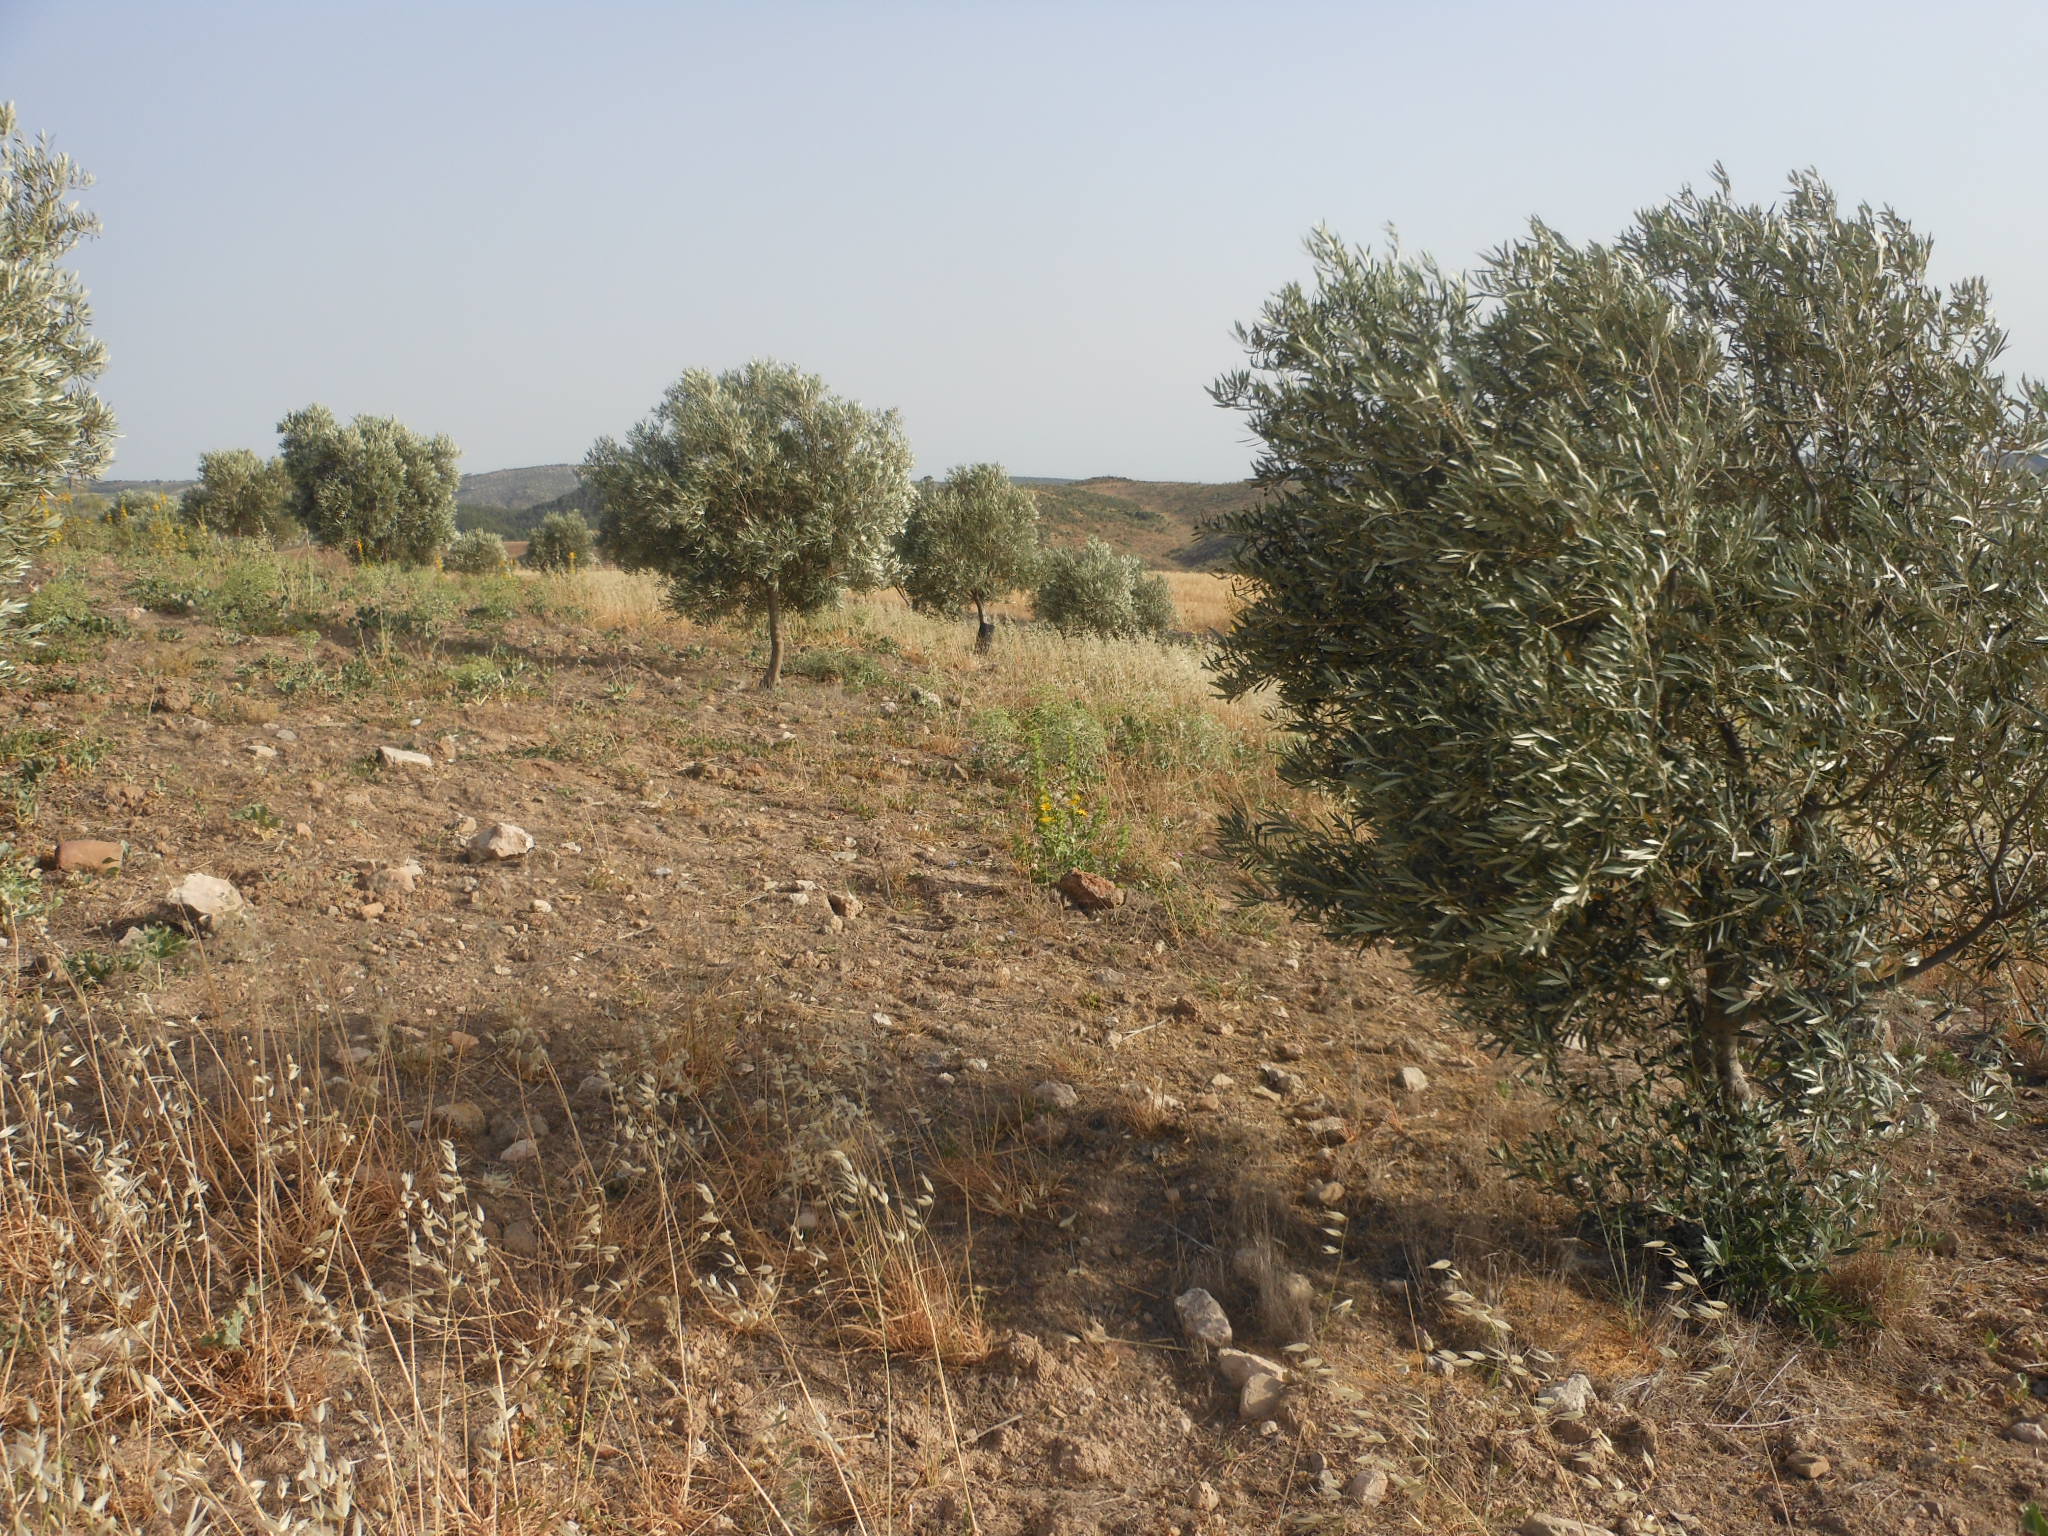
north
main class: Cropland
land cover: Olive groves
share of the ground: 10 - 25 %
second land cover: Spontaneously vegetated surfaces
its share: 50 - 75 %
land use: Agriculture (excluding fallow land and kitchen gardens)
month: June
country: ES
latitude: 37.1342
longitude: -5.0326
